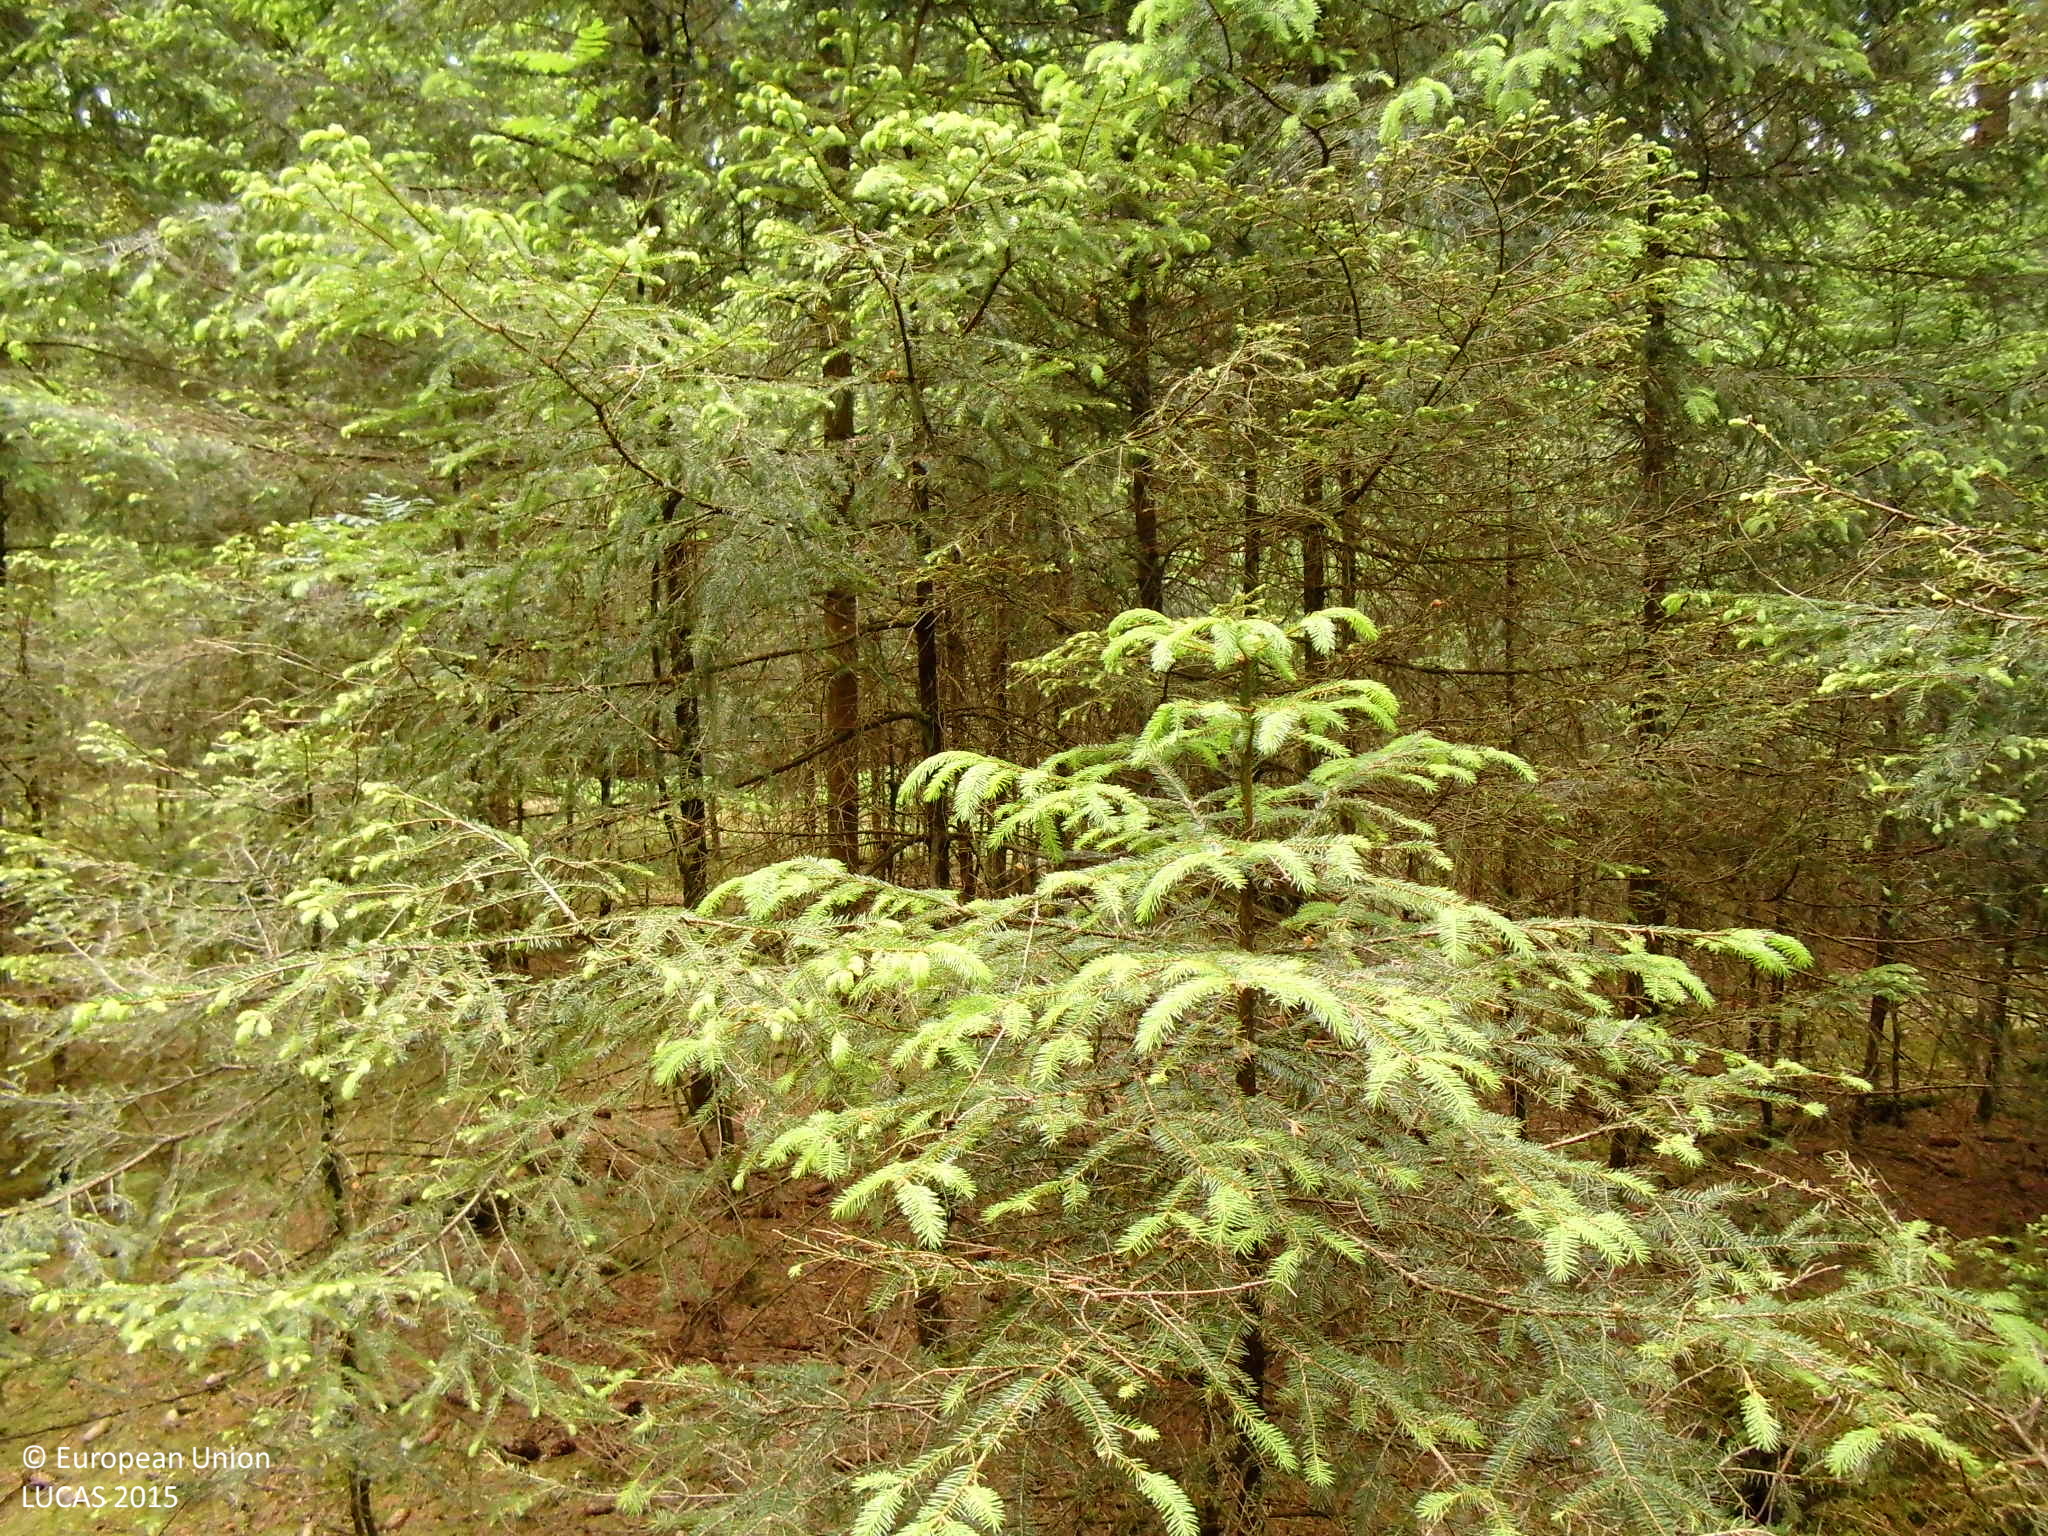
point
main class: Woodland
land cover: Spruce dominated coniferous woodland
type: hemiboreal forest and nemoral coniferous forest and mixed broadleaved-coniferous forest
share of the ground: > 75 %
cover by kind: coniferous forest trees 75 %, lichens and mosses 15 %, broadleaved forest trees 5 %, herbaceous plants 5 %
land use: Forestry
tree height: > 5 m
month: June
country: DE
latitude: 51.0478
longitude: 7.9891
